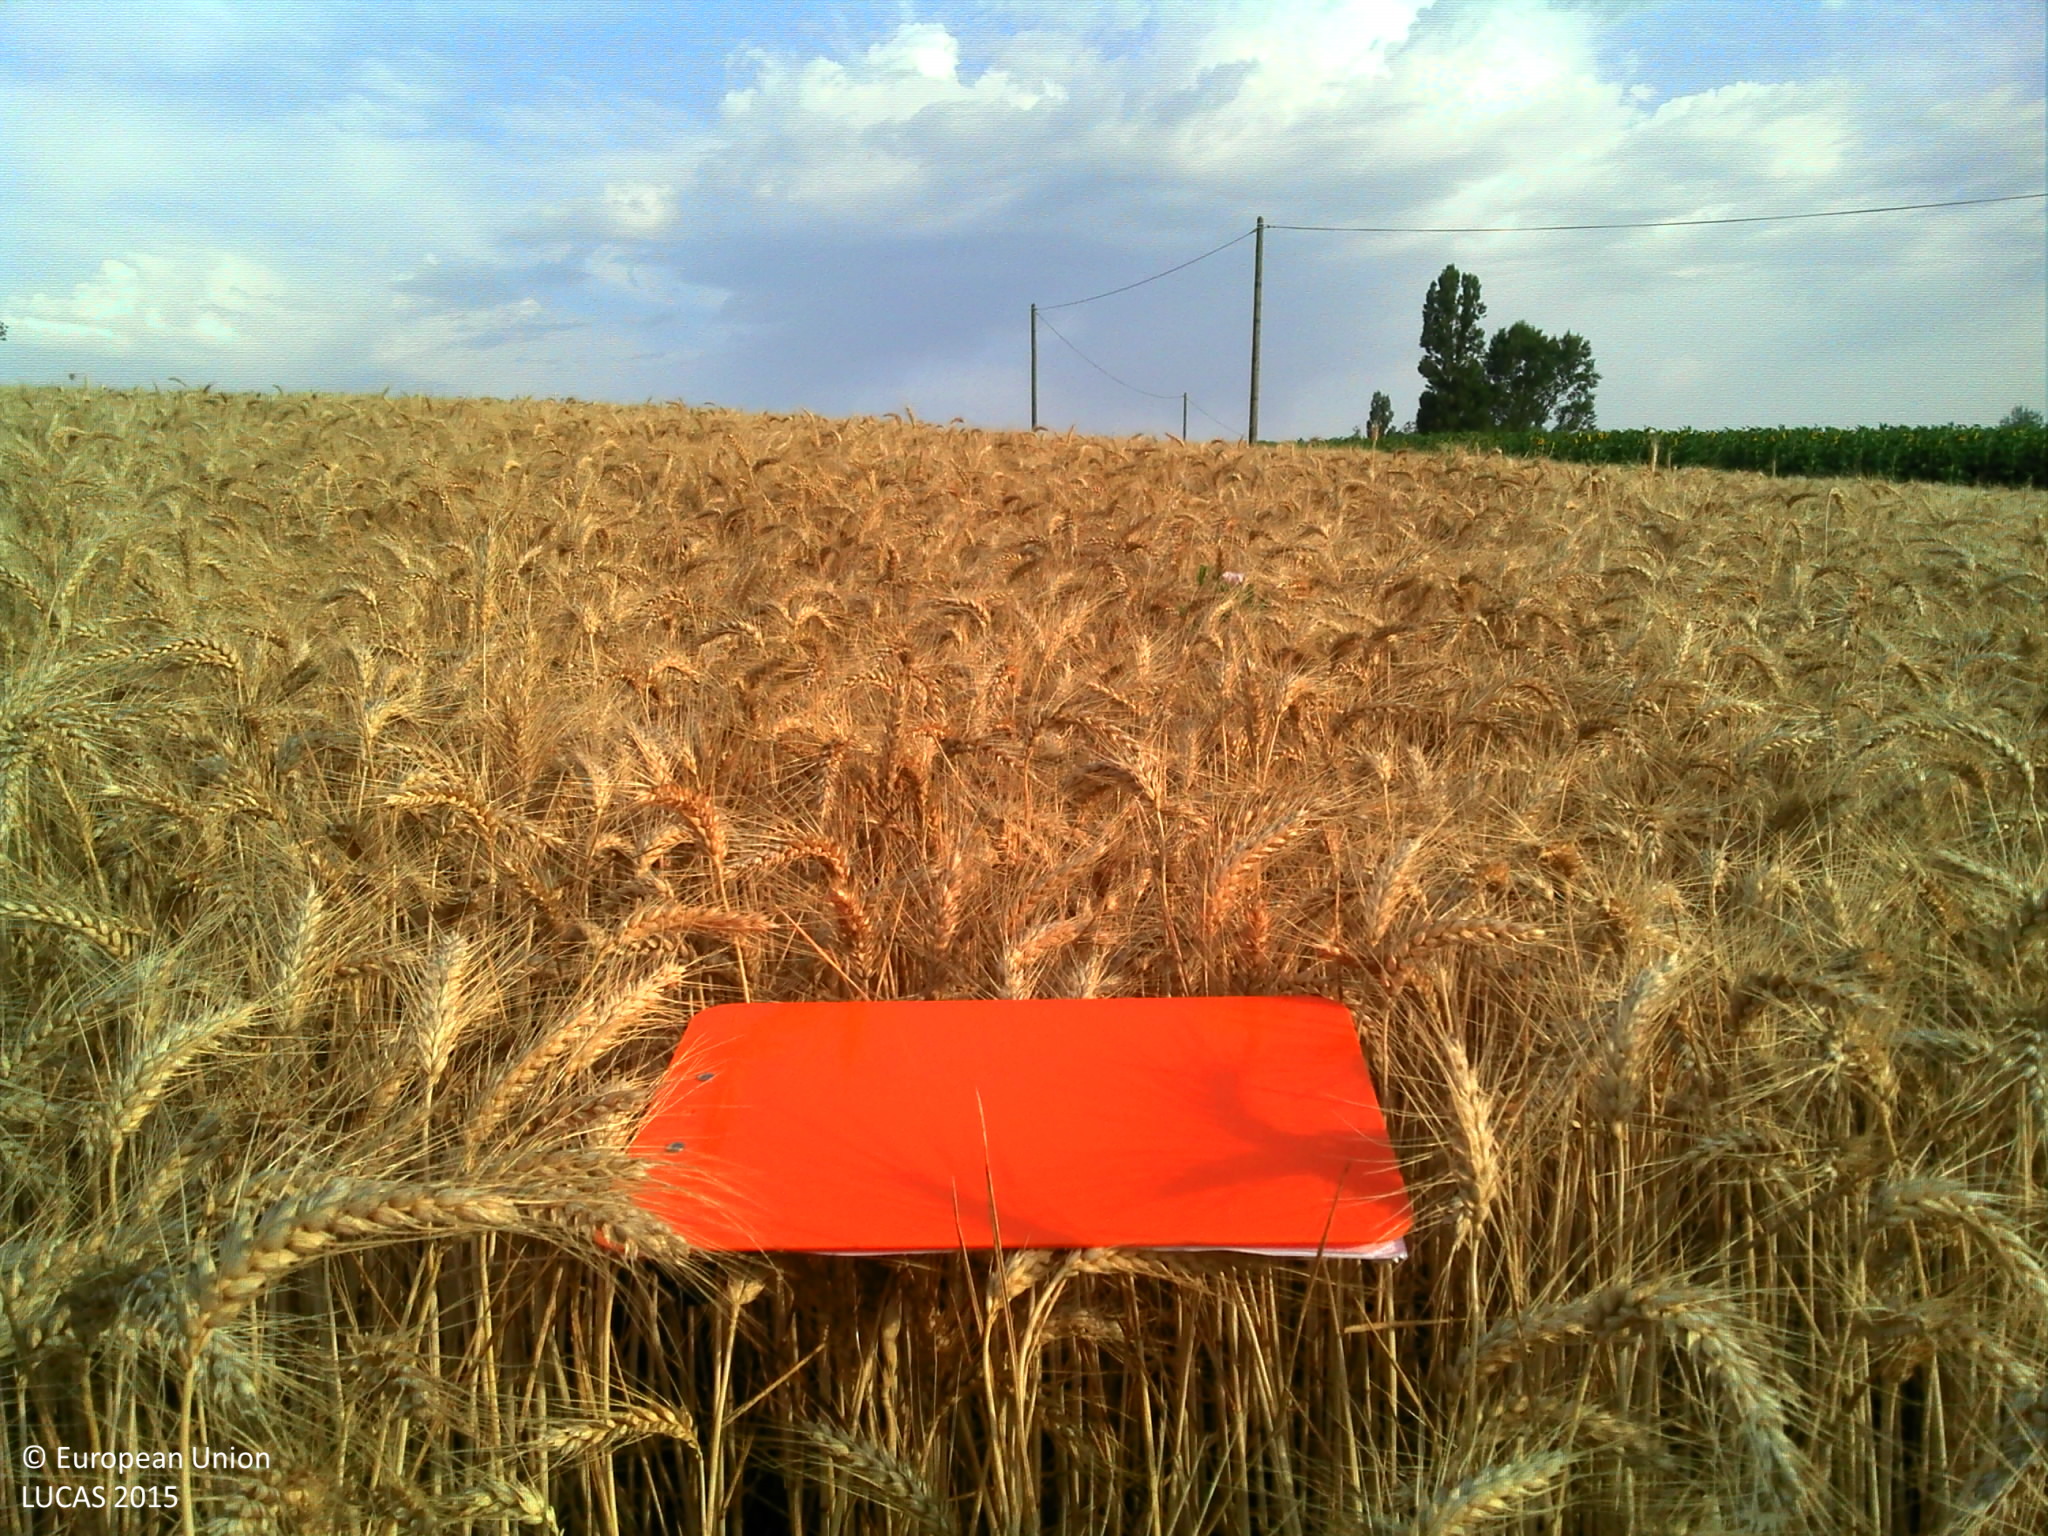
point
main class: Cropland
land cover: Common wheat
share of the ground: > 75 %
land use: Agriculture (excluding fallow land and kitchen gardens)
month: July
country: FR
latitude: 44.5035
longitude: 0.7999
